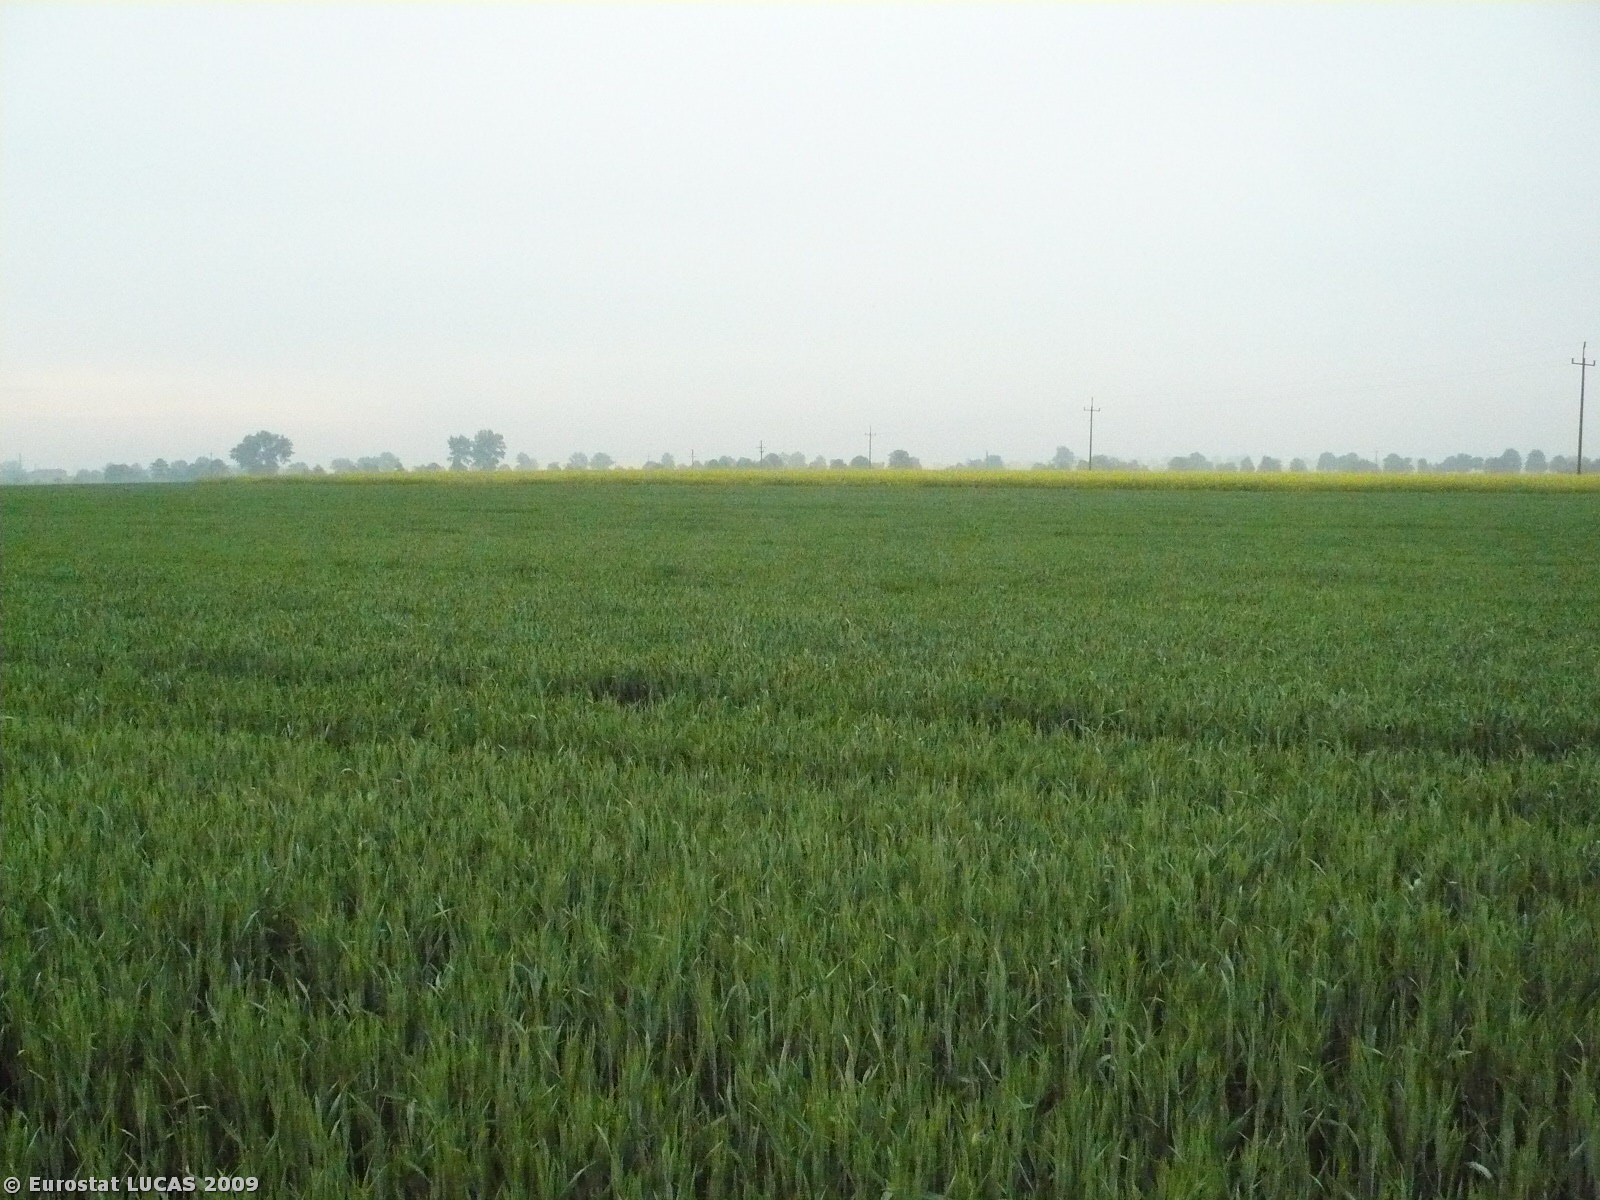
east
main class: Cropland
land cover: Durum wheat
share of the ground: > 75 %
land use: Agriculture (excluding fallow land and kitchen gardens)
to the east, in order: Durum wheat; Rape and turnip rape; Common wheat; Tracks; Common wheat
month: May
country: PL
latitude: 52.2079
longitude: 16.3434
